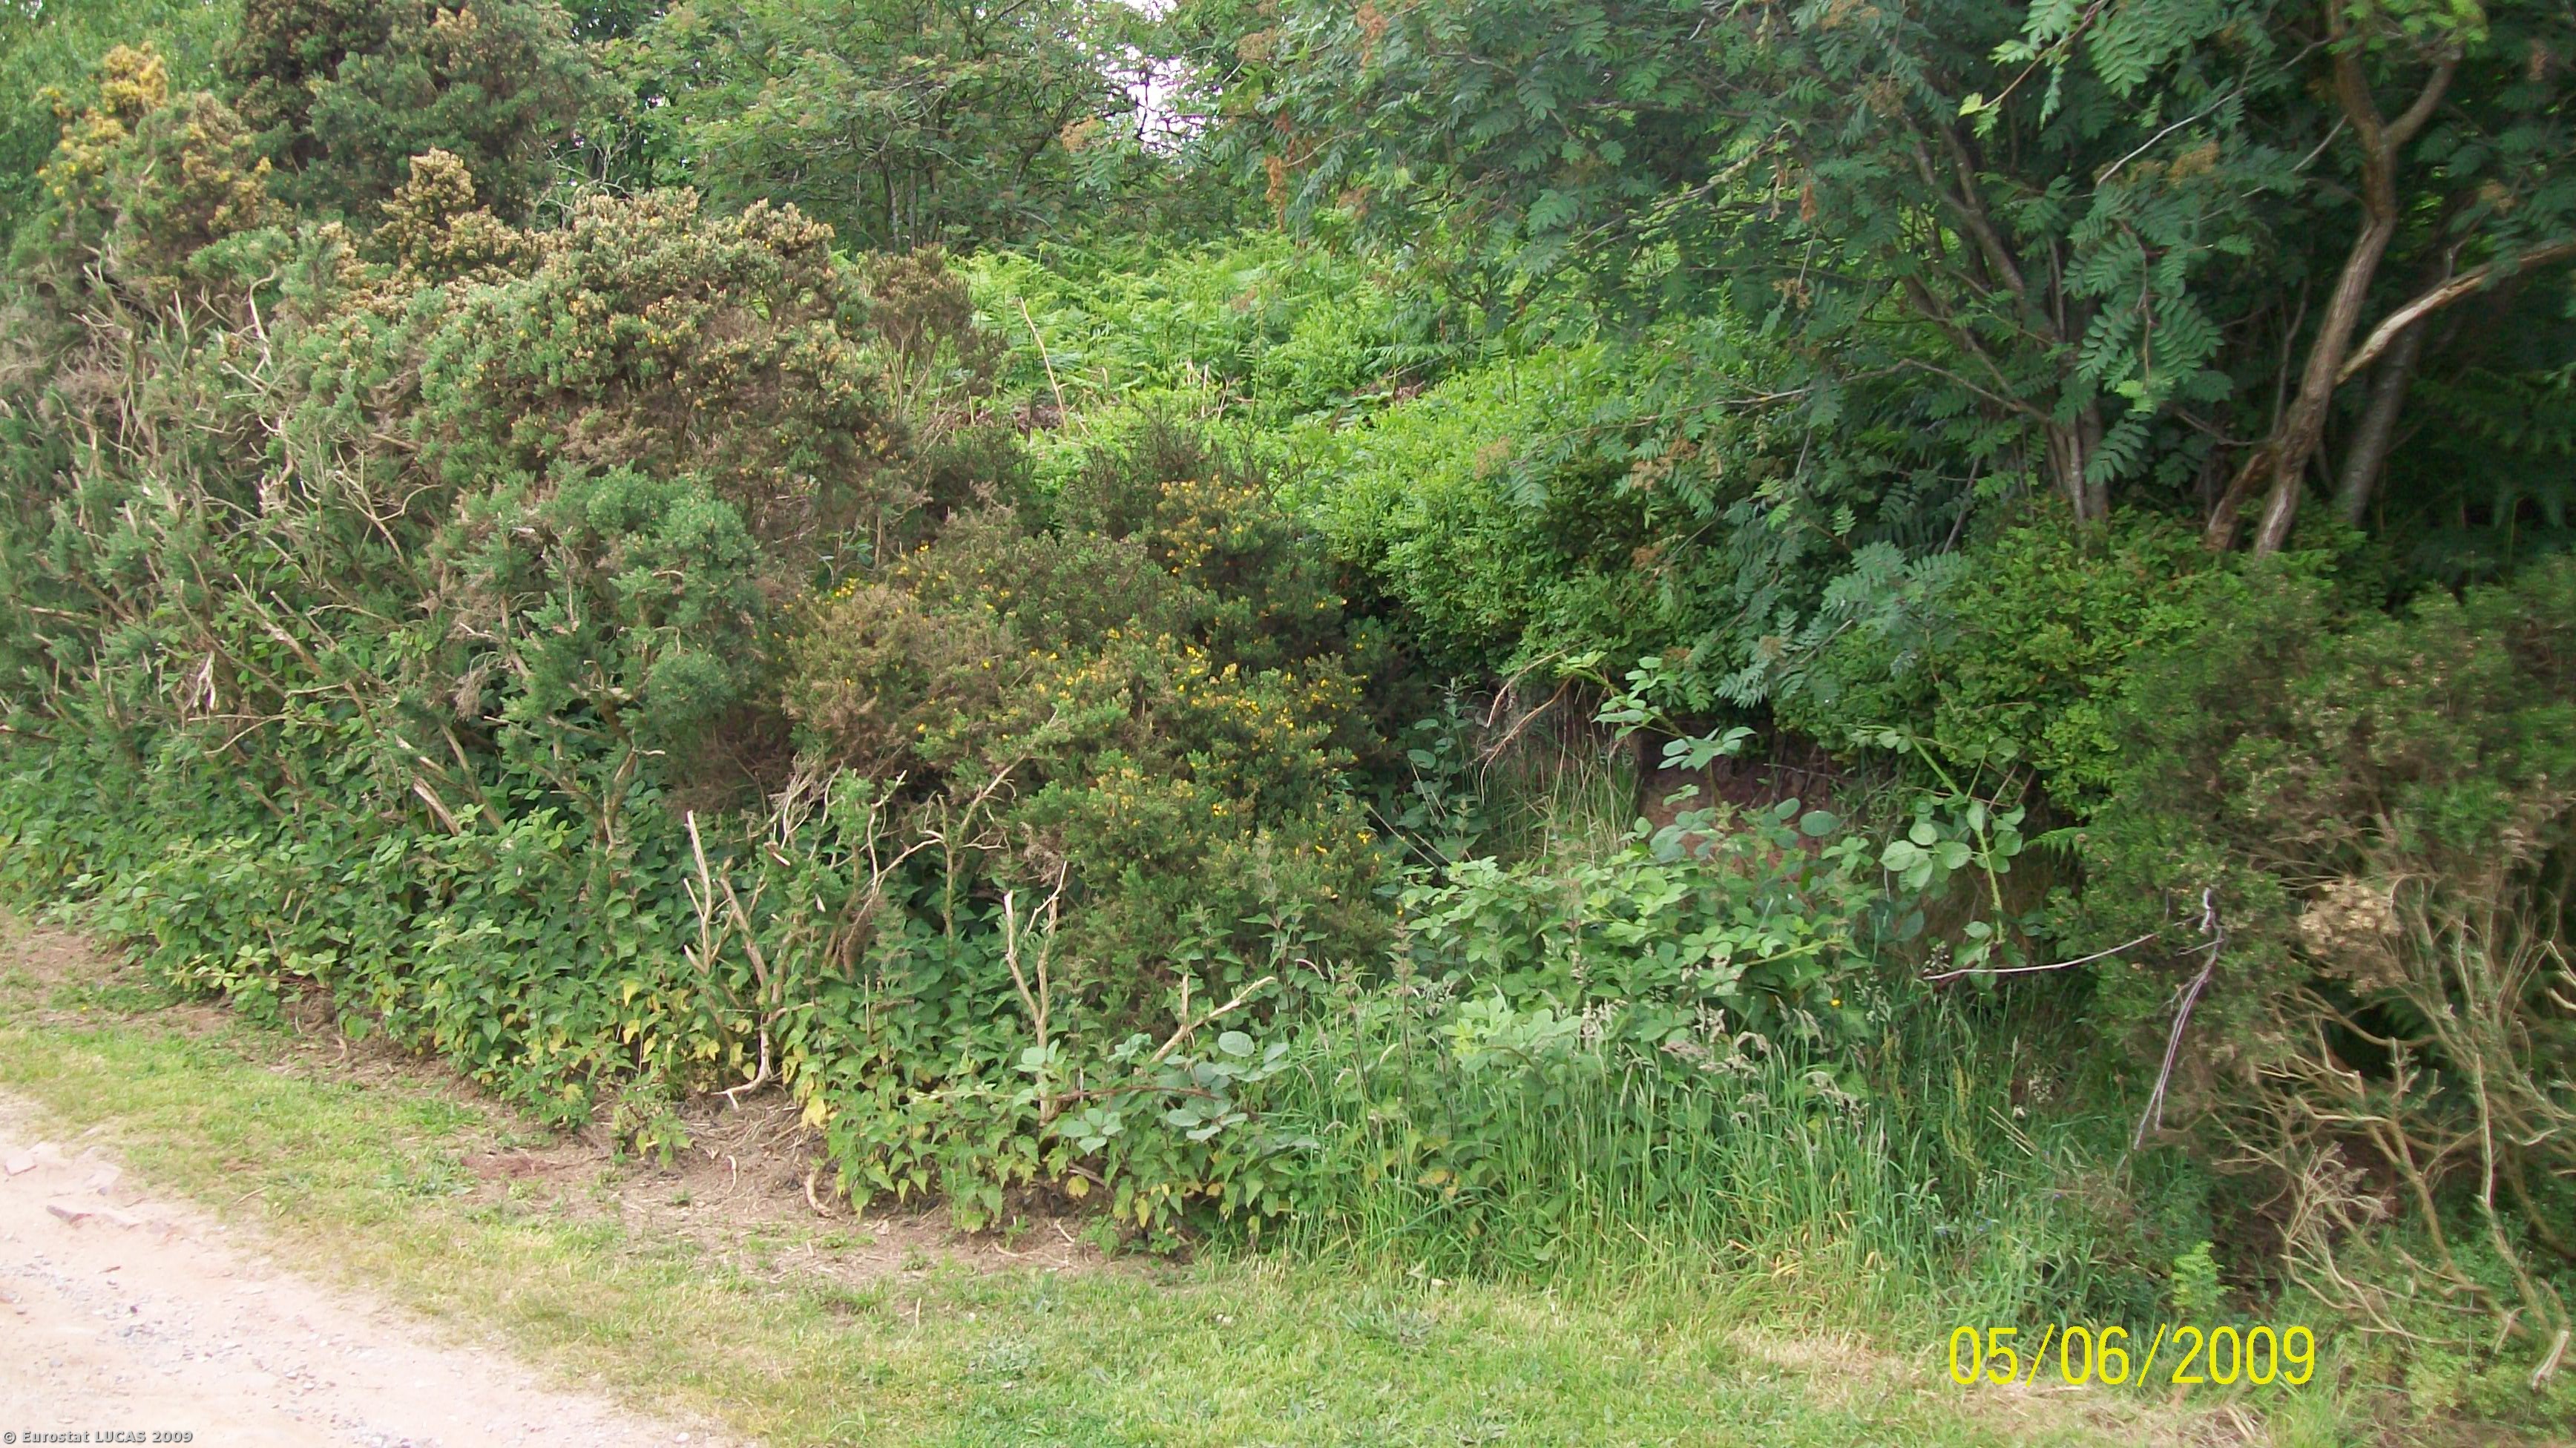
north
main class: Grassland
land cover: Grassland without tree/shrub cover
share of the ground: > 75 %
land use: Agriculture (excluding fallow land and kitchen gardens)
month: June
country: GB
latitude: 53.0922
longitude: -2.7174
